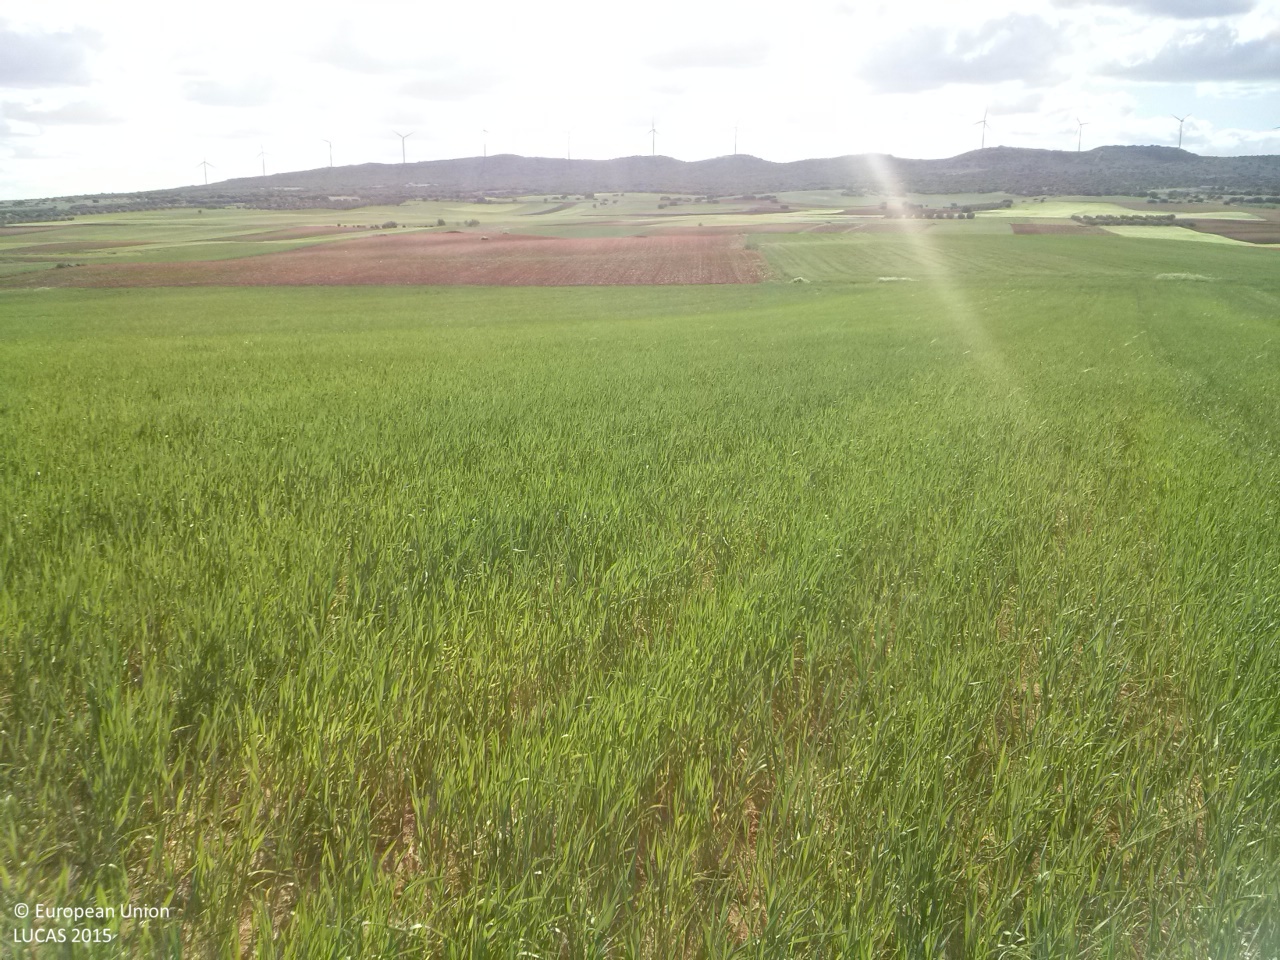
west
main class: Cropland
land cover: Barley
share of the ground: > 75 %
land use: Agriculture (excluding fallow land and kitchen gardens)
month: May
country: ES
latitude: 39.7546
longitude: -2.7987
